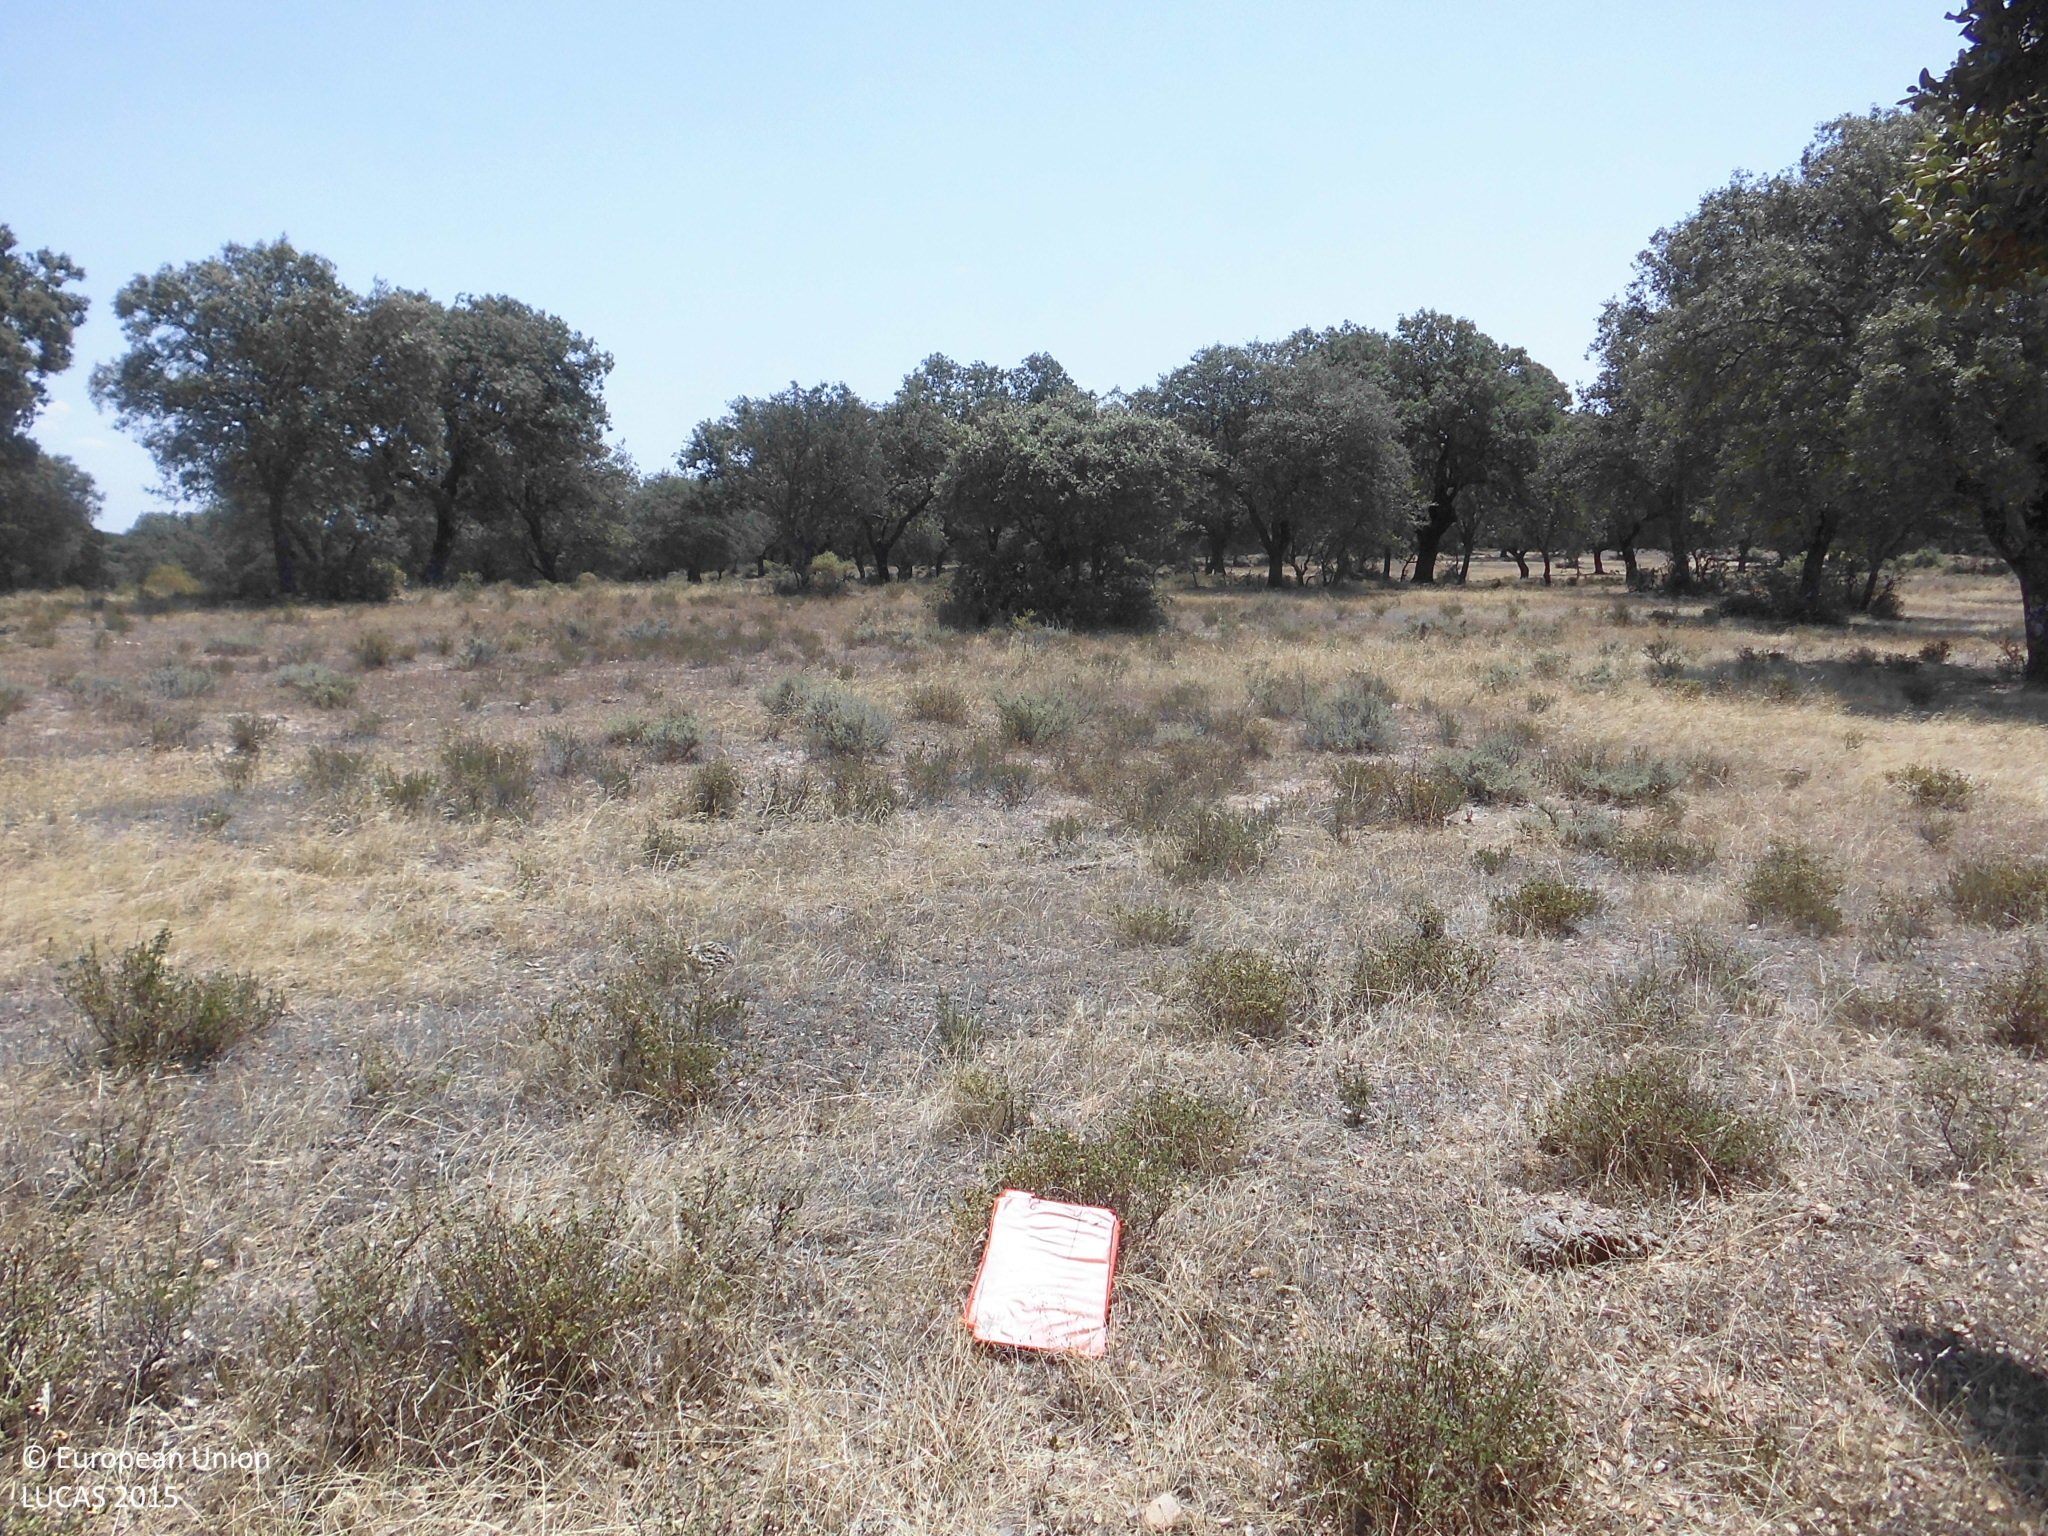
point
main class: Woodland
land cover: Broadleaved woodland
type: broadleaved evergreen forest
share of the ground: 10 - 25 %
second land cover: Grassland without tree/shrub cover
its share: > 75 %
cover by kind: herbaceous plants 75 %, broadleaved forest trees 20 %, shrubs 5 %
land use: Forestry
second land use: Agriculture (excluding fallow land and kitchen gardens)
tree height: > 5 m
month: July
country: ES
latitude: 39.8985
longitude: -5.7947
